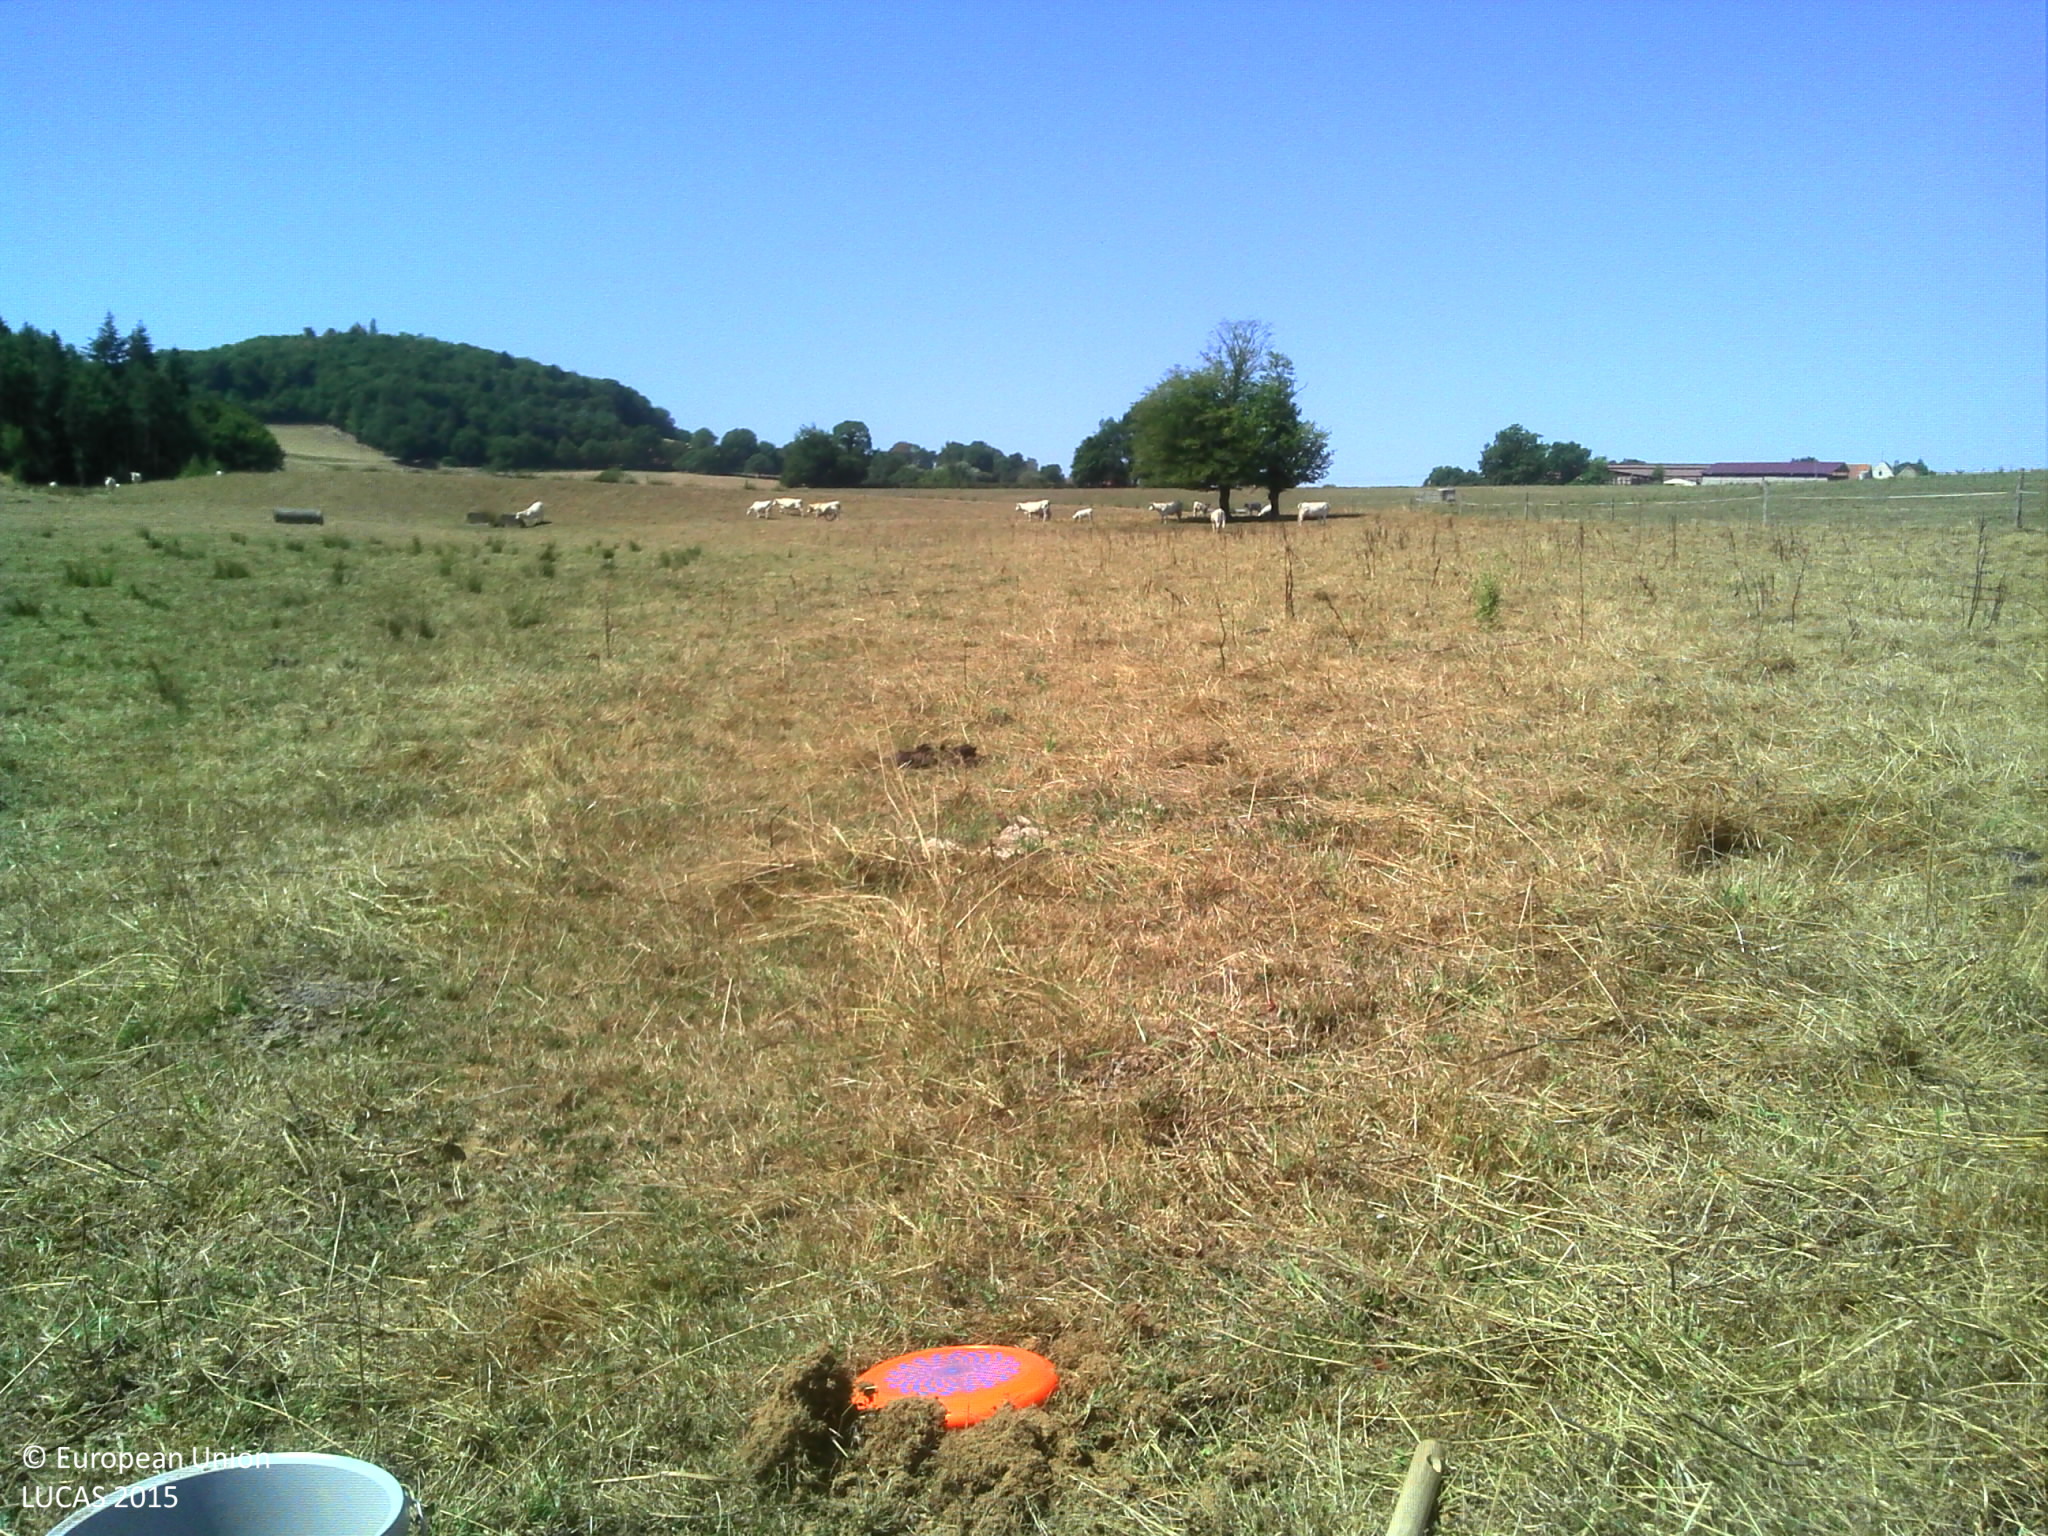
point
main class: Grassland
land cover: Grassland without tree/shrub cover
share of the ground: > 75 %
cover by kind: herbaceous plants 100 %
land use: Agriculture (excluding fallow land and kitchen gardens)
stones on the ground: 10 - 25 %
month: August
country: FR
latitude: 46.6775
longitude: 4.4710
